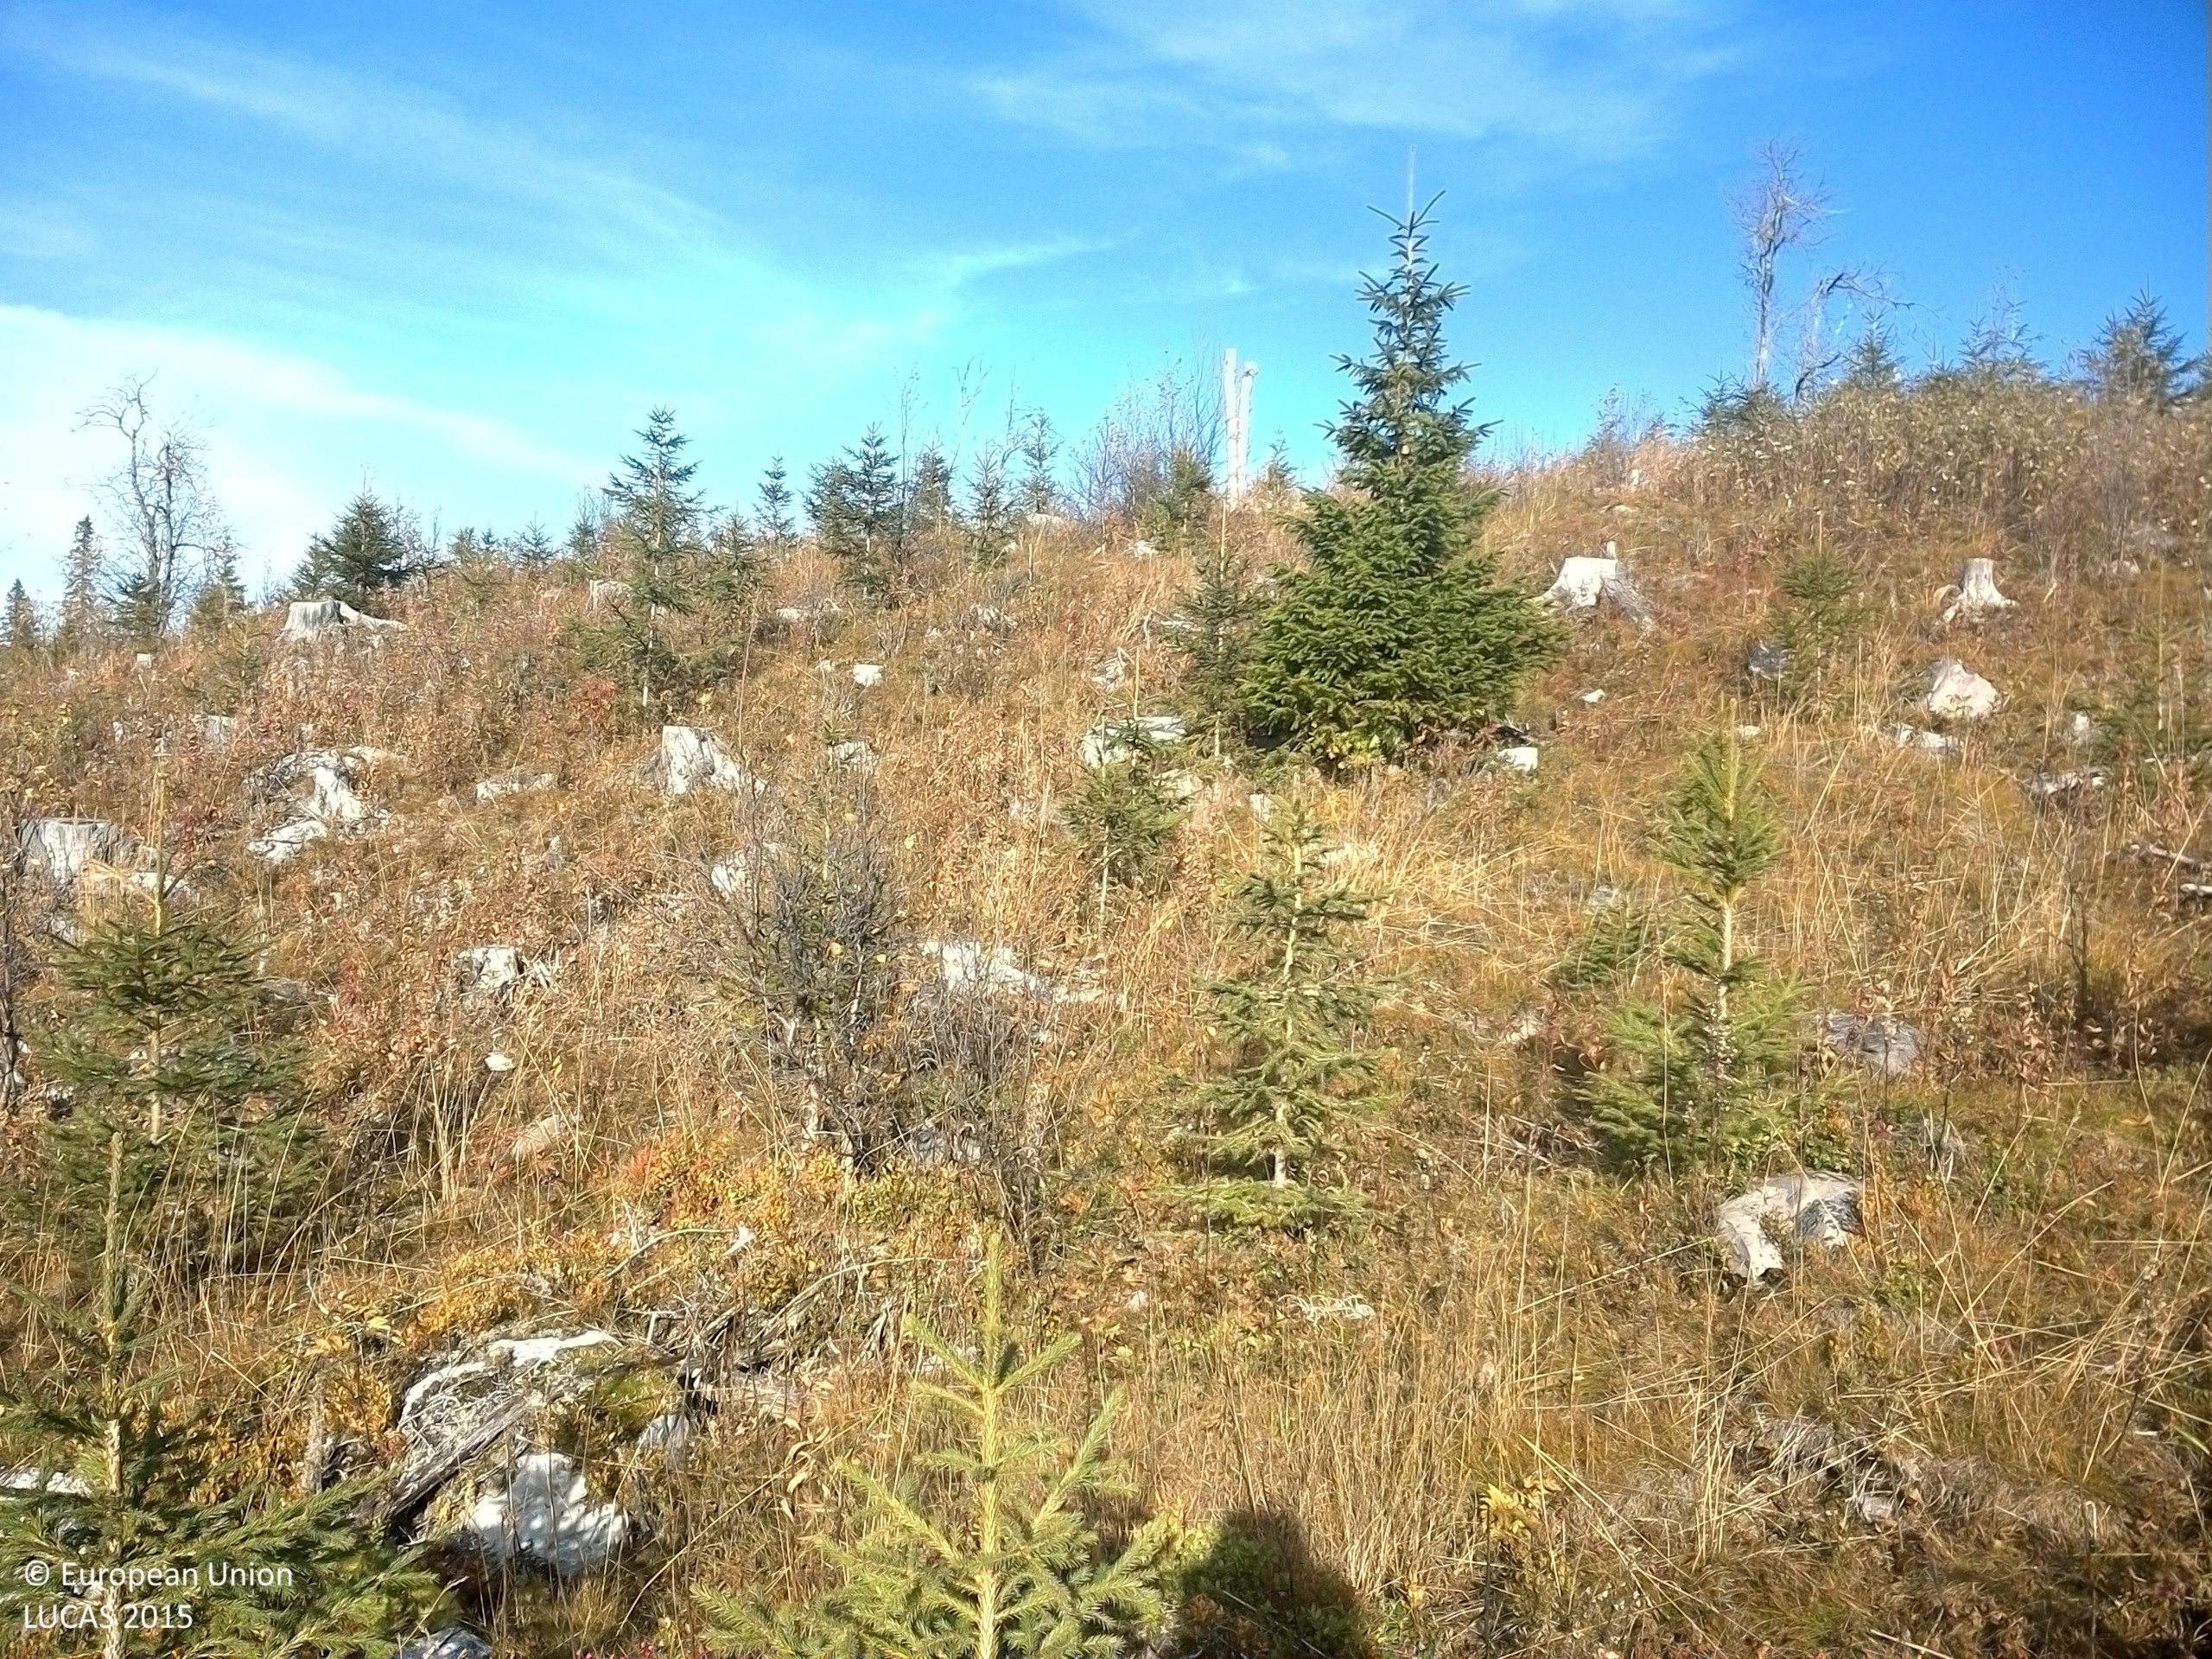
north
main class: Woodland
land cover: Spruce dominated mixed woodland
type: boreal forest
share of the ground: 10 - 25 %
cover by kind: herbaceous plants 45 %, shrubs 20 %, lichens and mosses 20 %, coniferous forest trees 10 %, broadleaved forest trees 5 %
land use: Forestry
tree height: < 5 m
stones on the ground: > 50 %
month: October
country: SE
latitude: 64.5218
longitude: 15.4498
